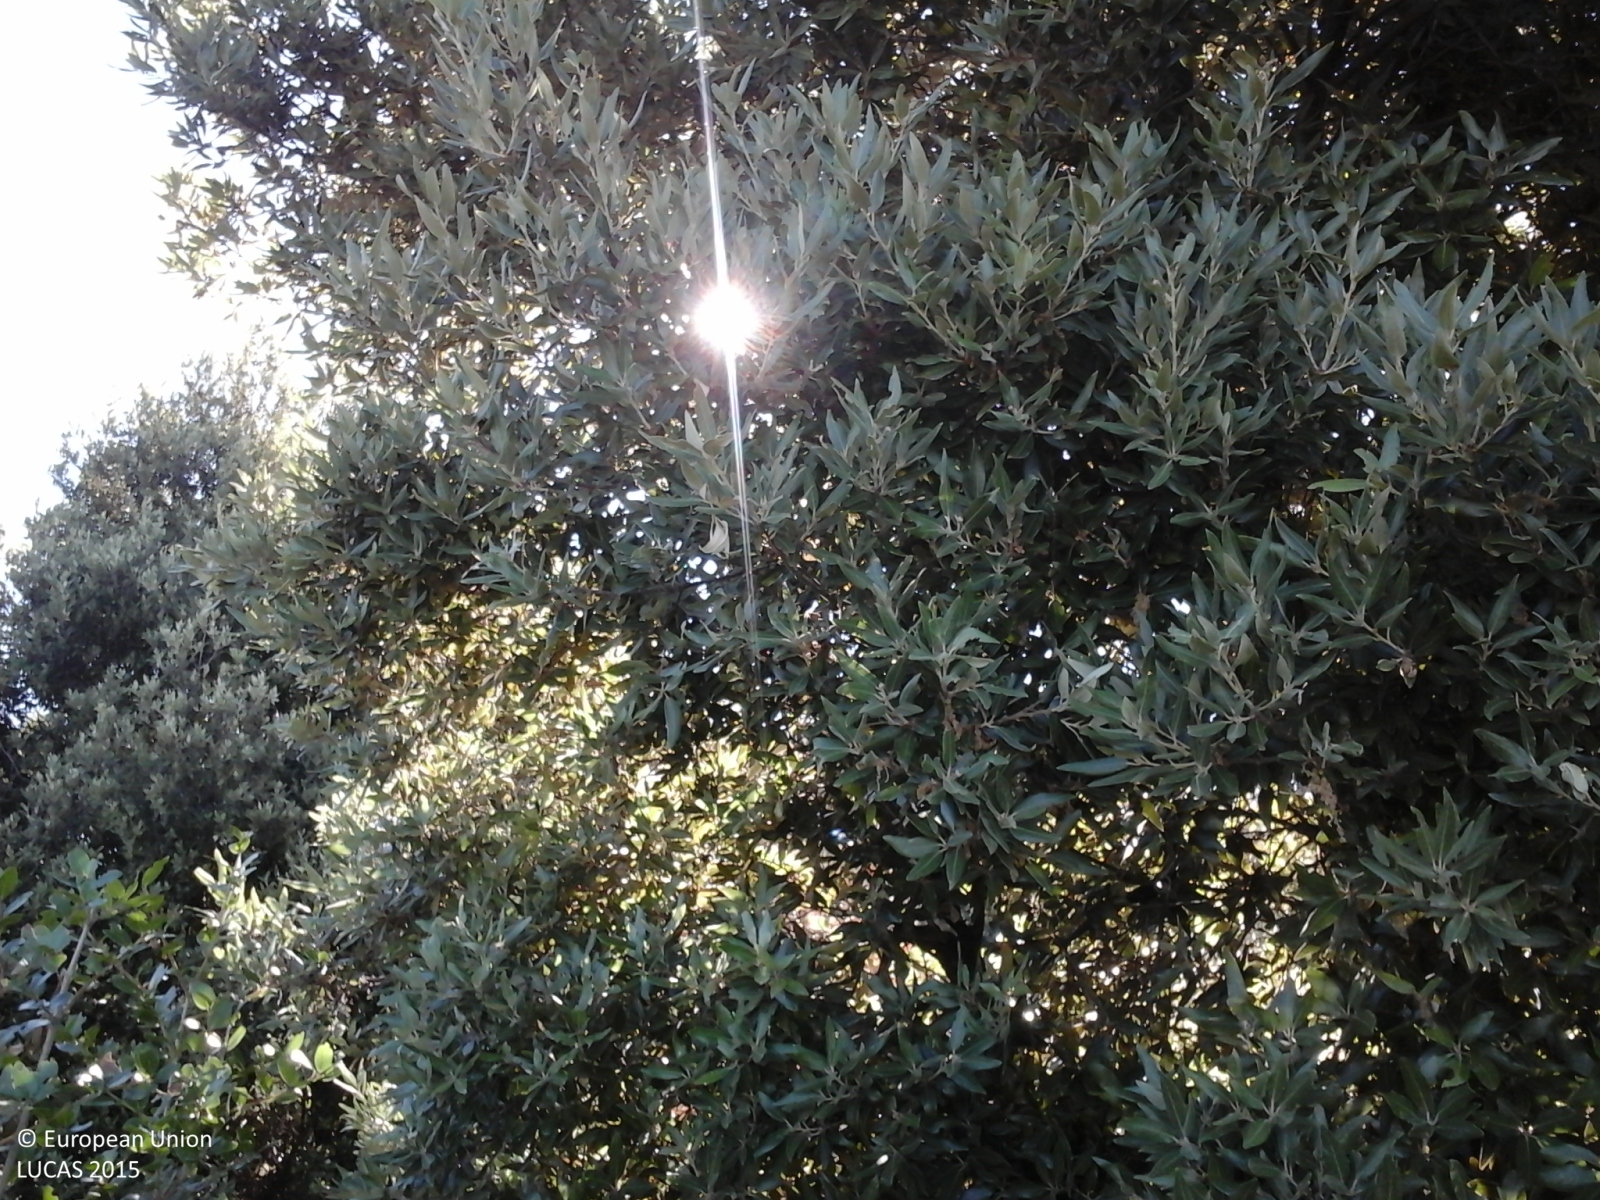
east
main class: Woodland
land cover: Broadleaved woodland
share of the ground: > 75 %
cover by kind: broadleaved forest trees 60 %, shrubs 20 %, coniferous forest trees 10 %, herbaceous plants 5 %, unconsolidated bare surface 5 %
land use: Amenities, museums, leisure
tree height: < 5 m
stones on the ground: > 50 %
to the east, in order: Broadleaved woodland; Other bare soil
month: June
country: IT
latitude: 37.7325
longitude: 14.8565
